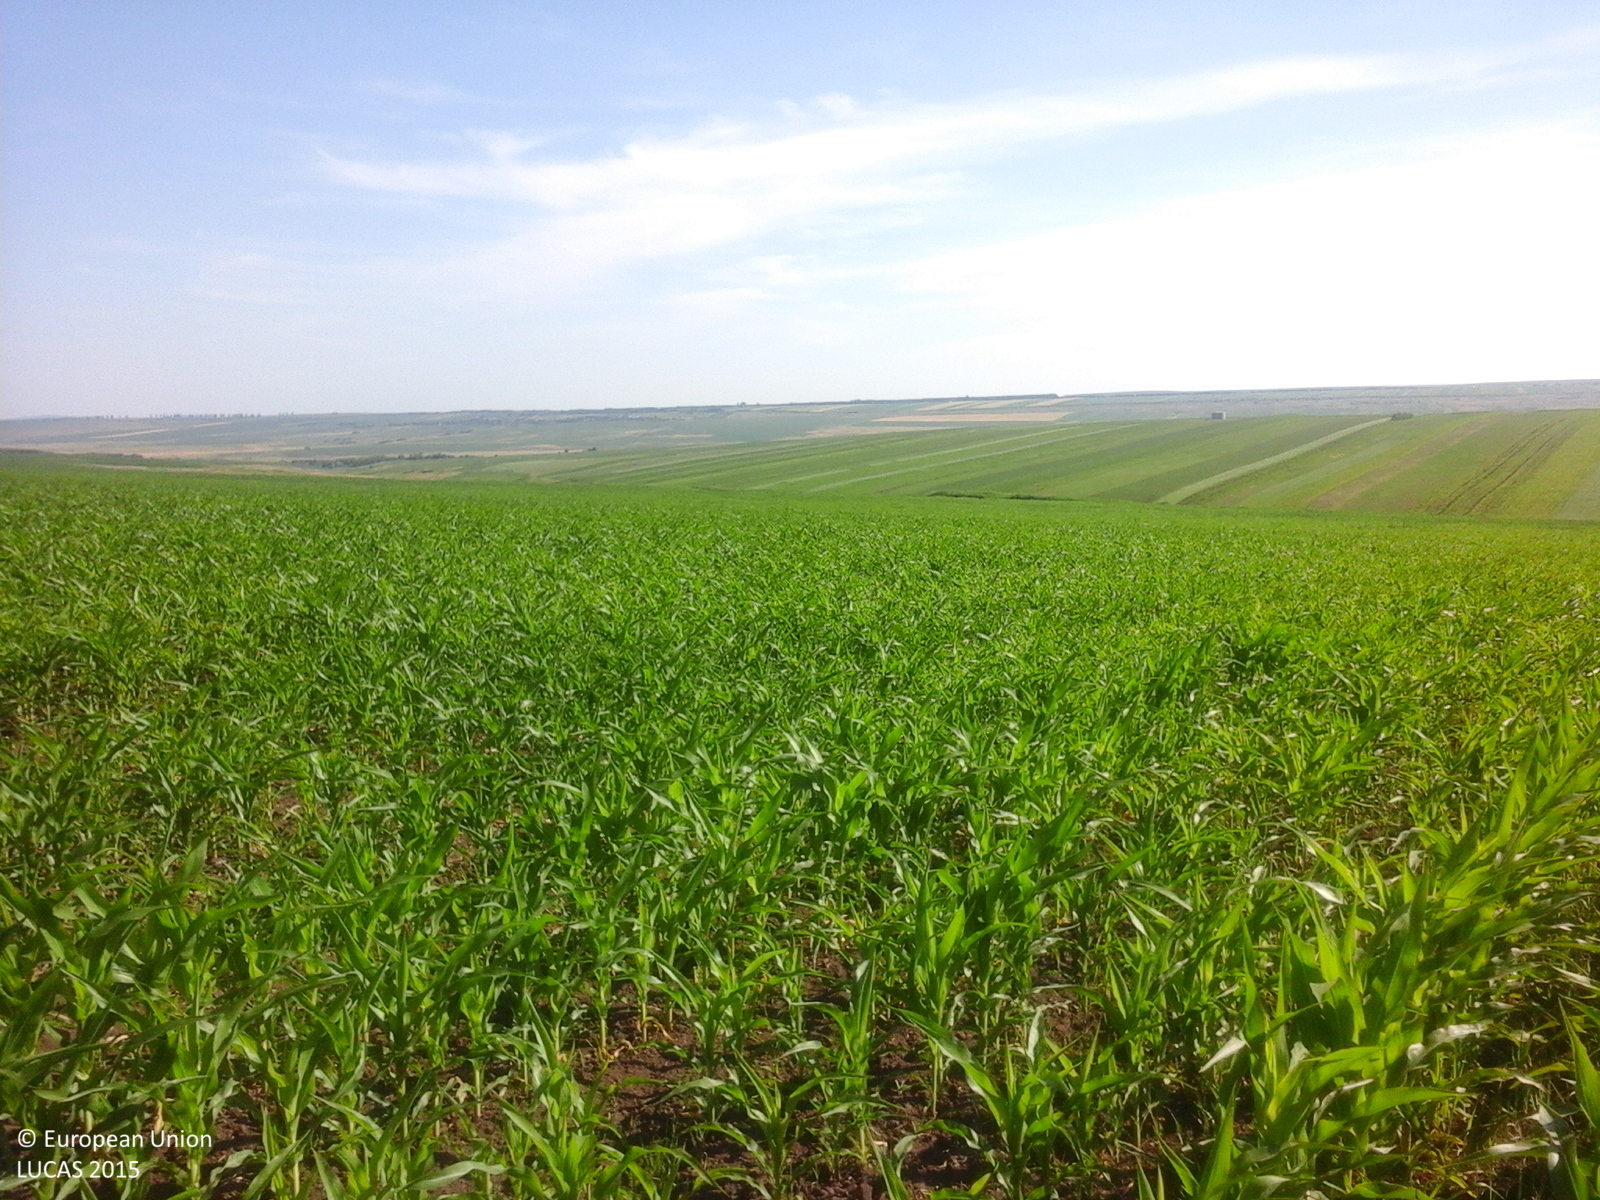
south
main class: Cropland
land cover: Maize
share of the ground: 50 - 75 %
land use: Agriculture (excluding fallow land and kitchen gardens)
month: June
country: RO
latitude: 47.8806
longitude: 27.1320
